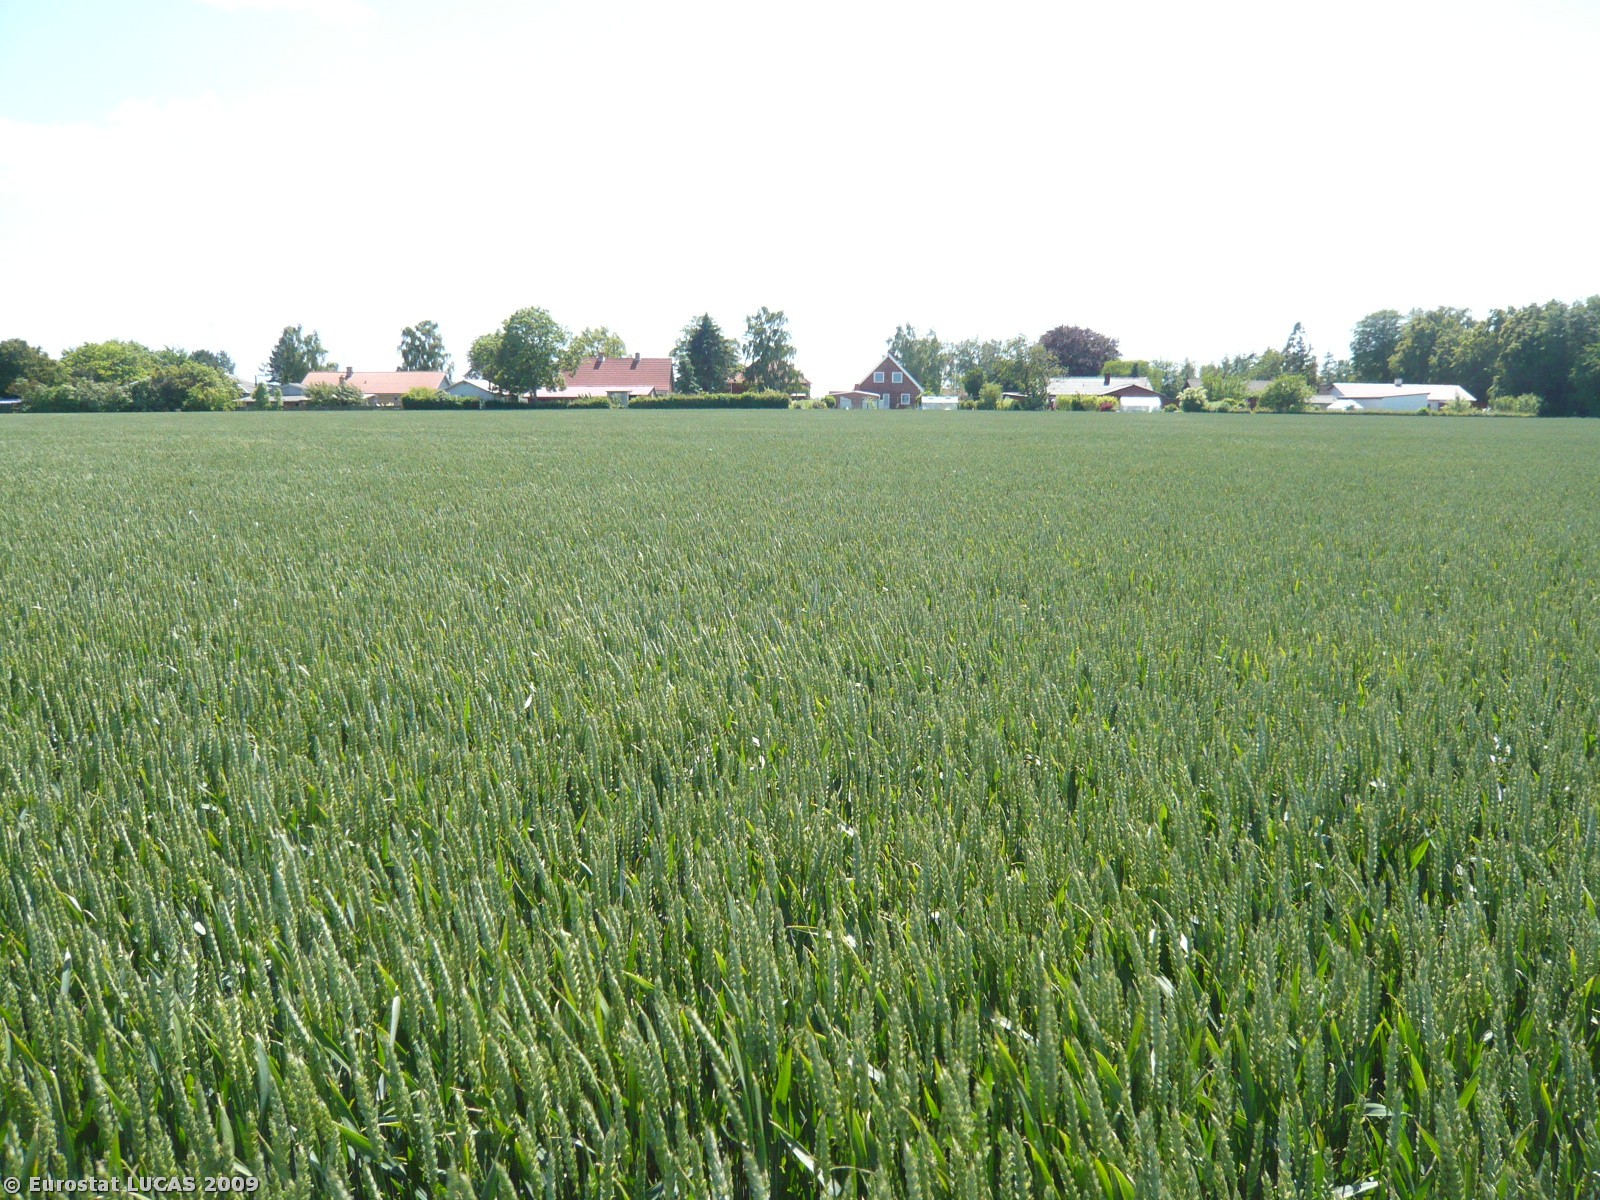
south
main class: Cropland
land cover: Common wheat
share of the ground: > 75 %
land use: Agriculture (excluding fallow land and kitchen gardens)
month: June
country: DK
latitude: 54.7621
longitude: 11.1958
